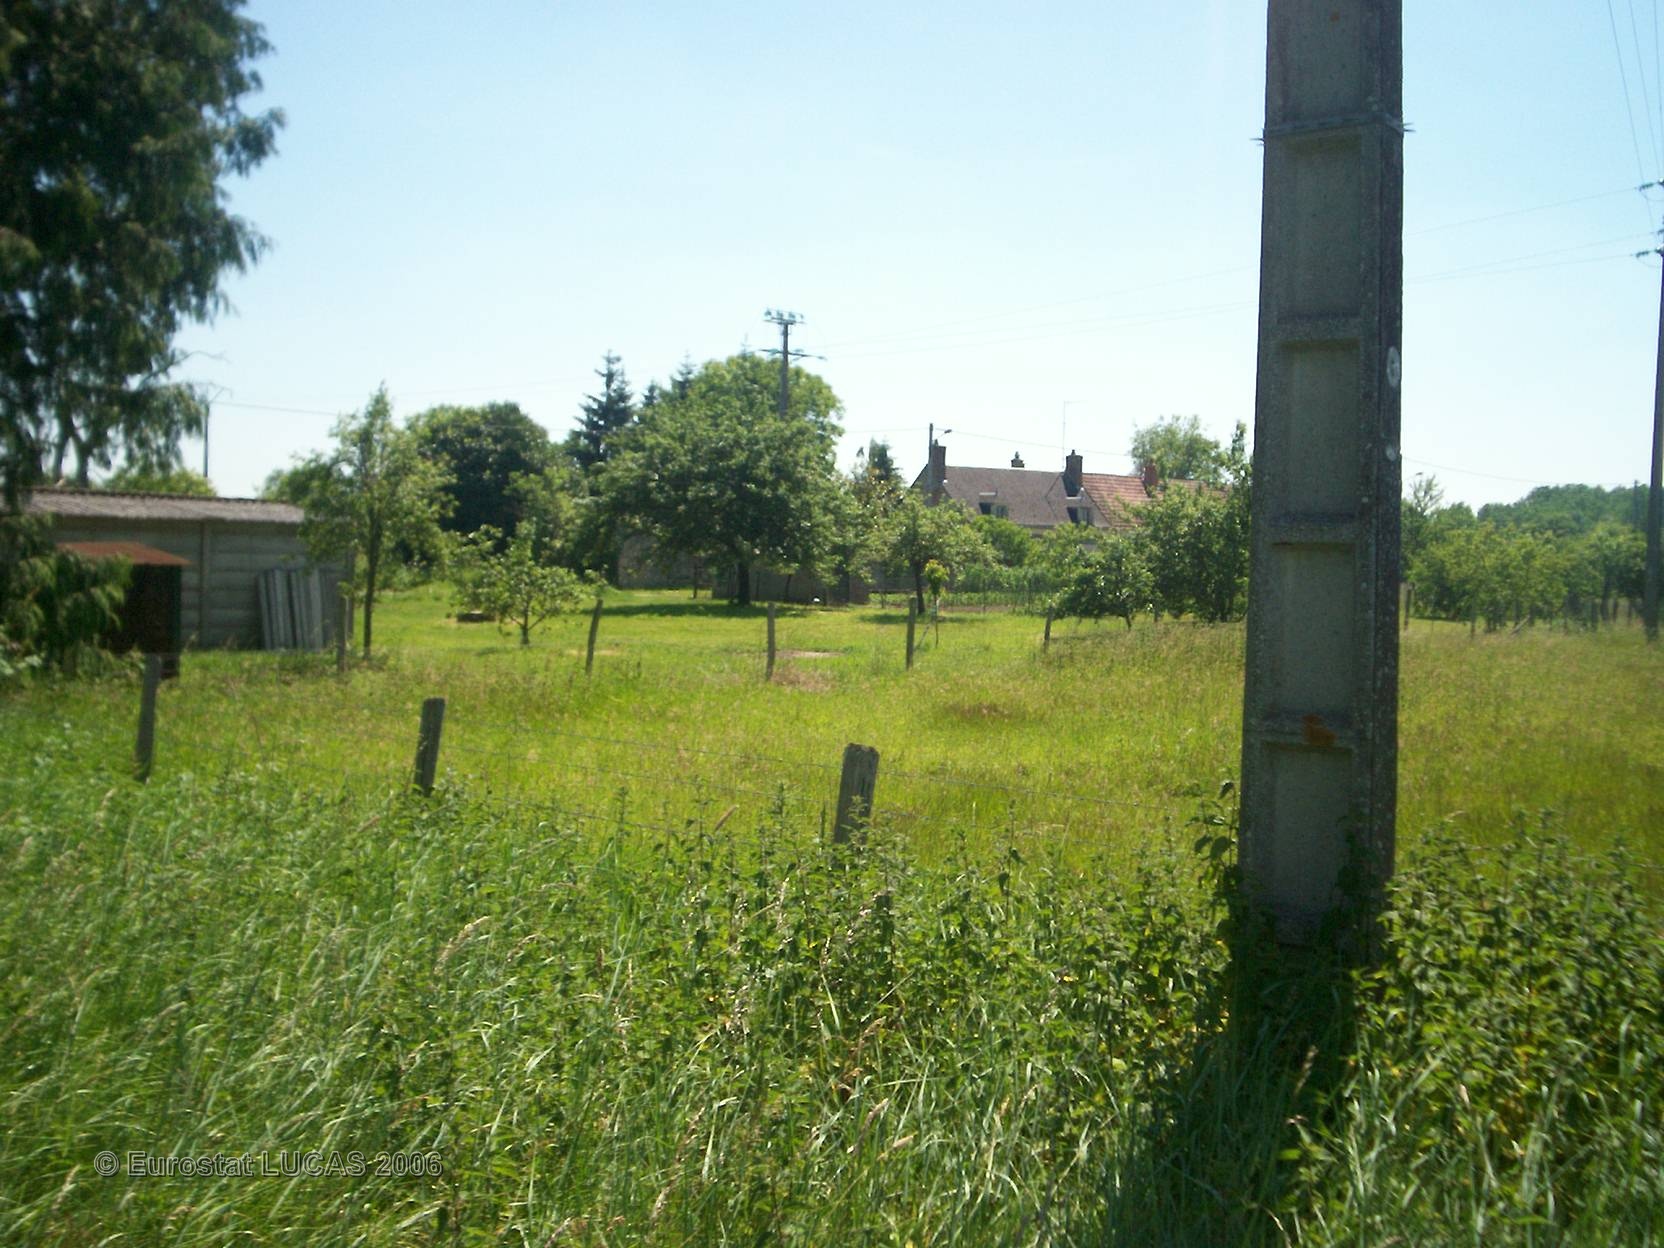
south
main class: Grassland
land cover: Grassland without tree/shrub cover
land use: Agriculture (excluding fallow land and kitchen gardens)
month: June
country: FR
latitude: 46.9577
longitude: 3.0709
